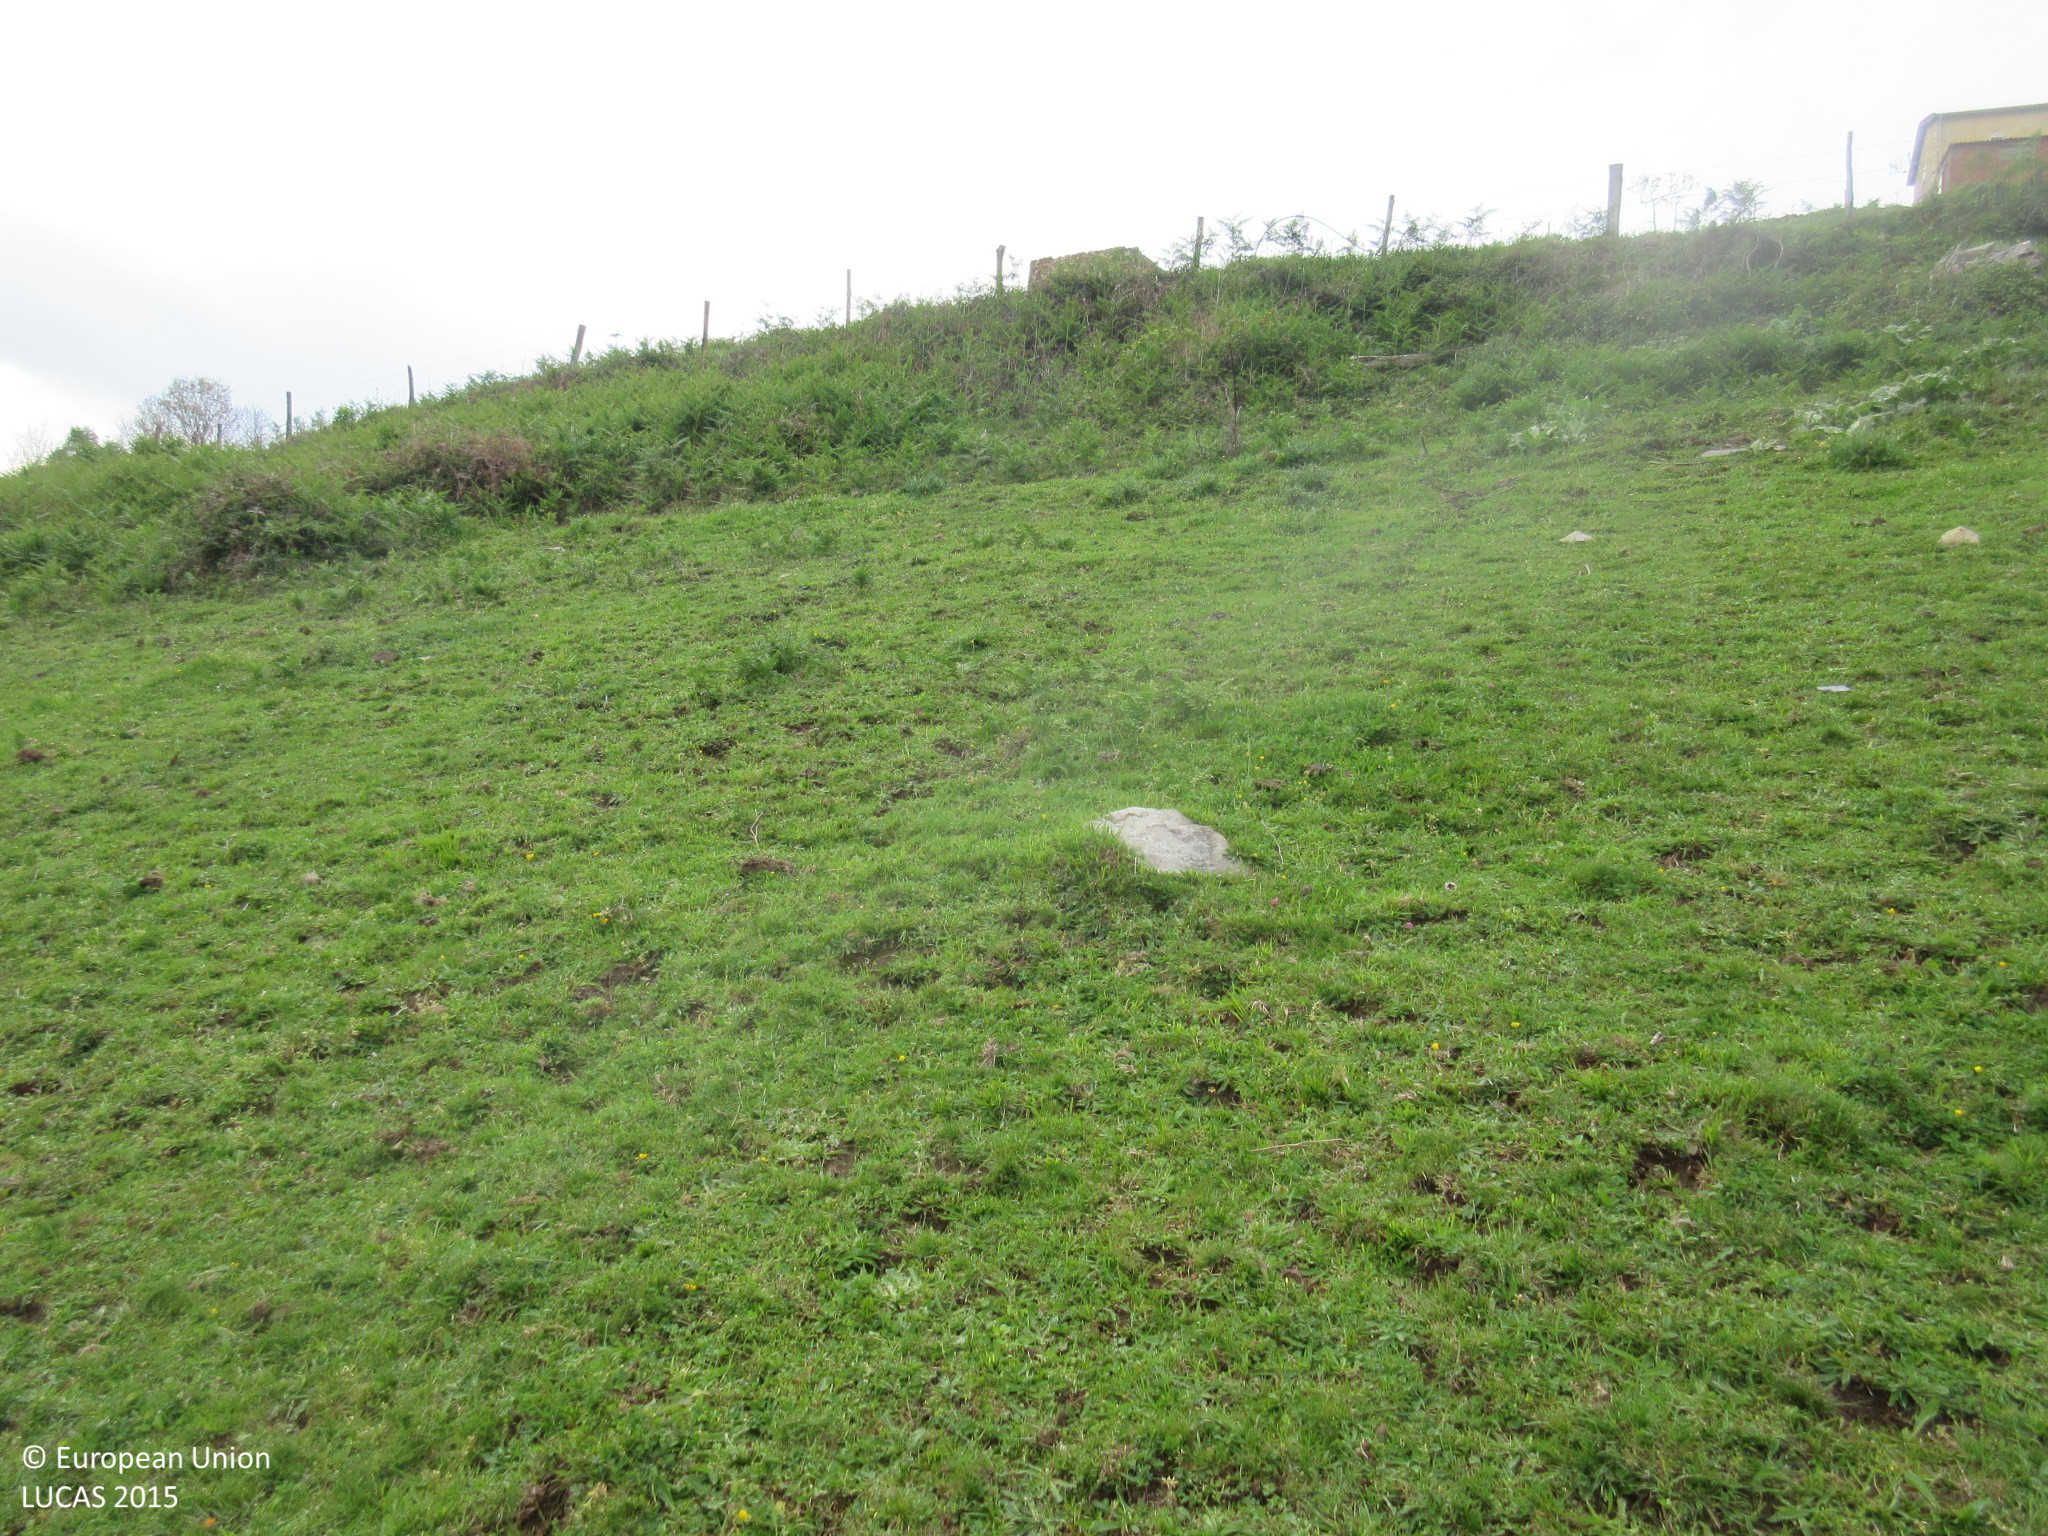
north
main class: Grassland
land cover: Grassland without tree/shrub cover
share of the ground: > 75 %
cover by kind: herbaceous plants 100 %
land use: Agriculture (excluding fallow land and kitchen gardens)
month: April
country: ES
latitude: 43.5138
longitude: -6.3939
